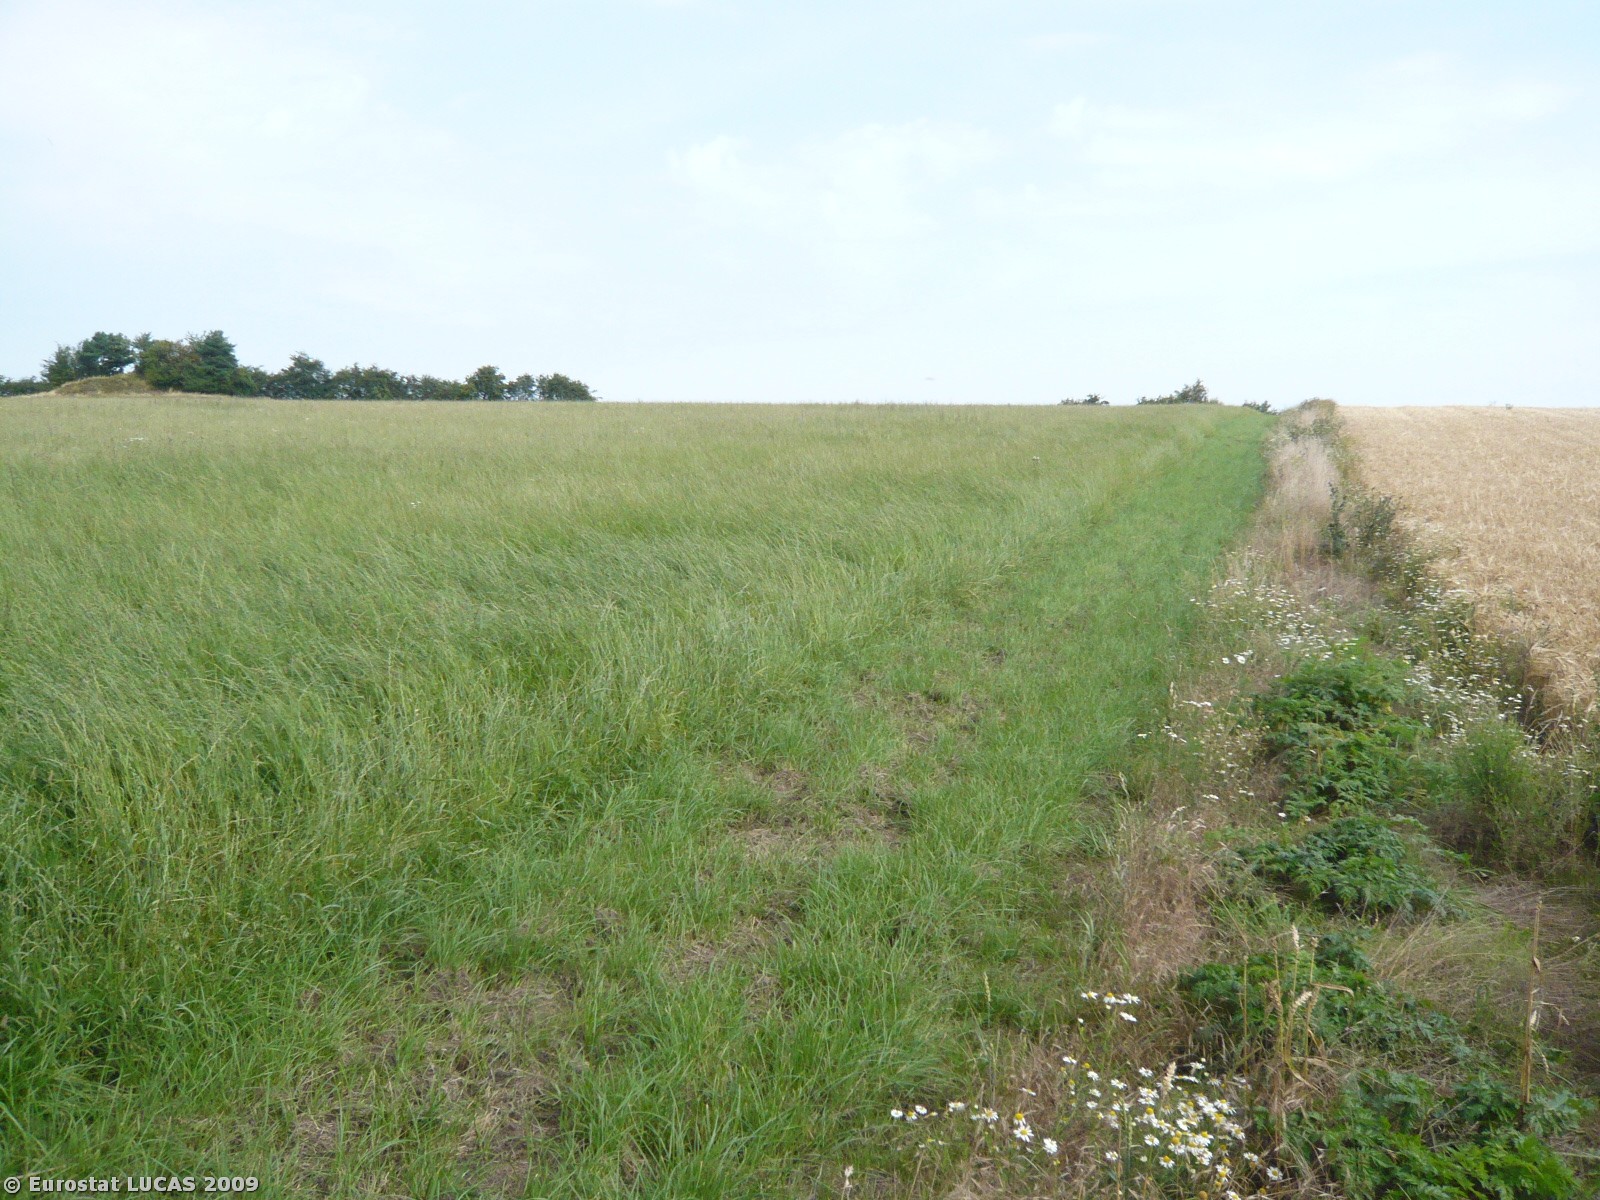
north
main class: Cropland
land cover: Barley
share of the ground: > 75 %
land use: Agriculture (excluding fallow land and kitchen gardens)
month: August
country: DK
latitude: 56.0257
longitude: 12.1640
